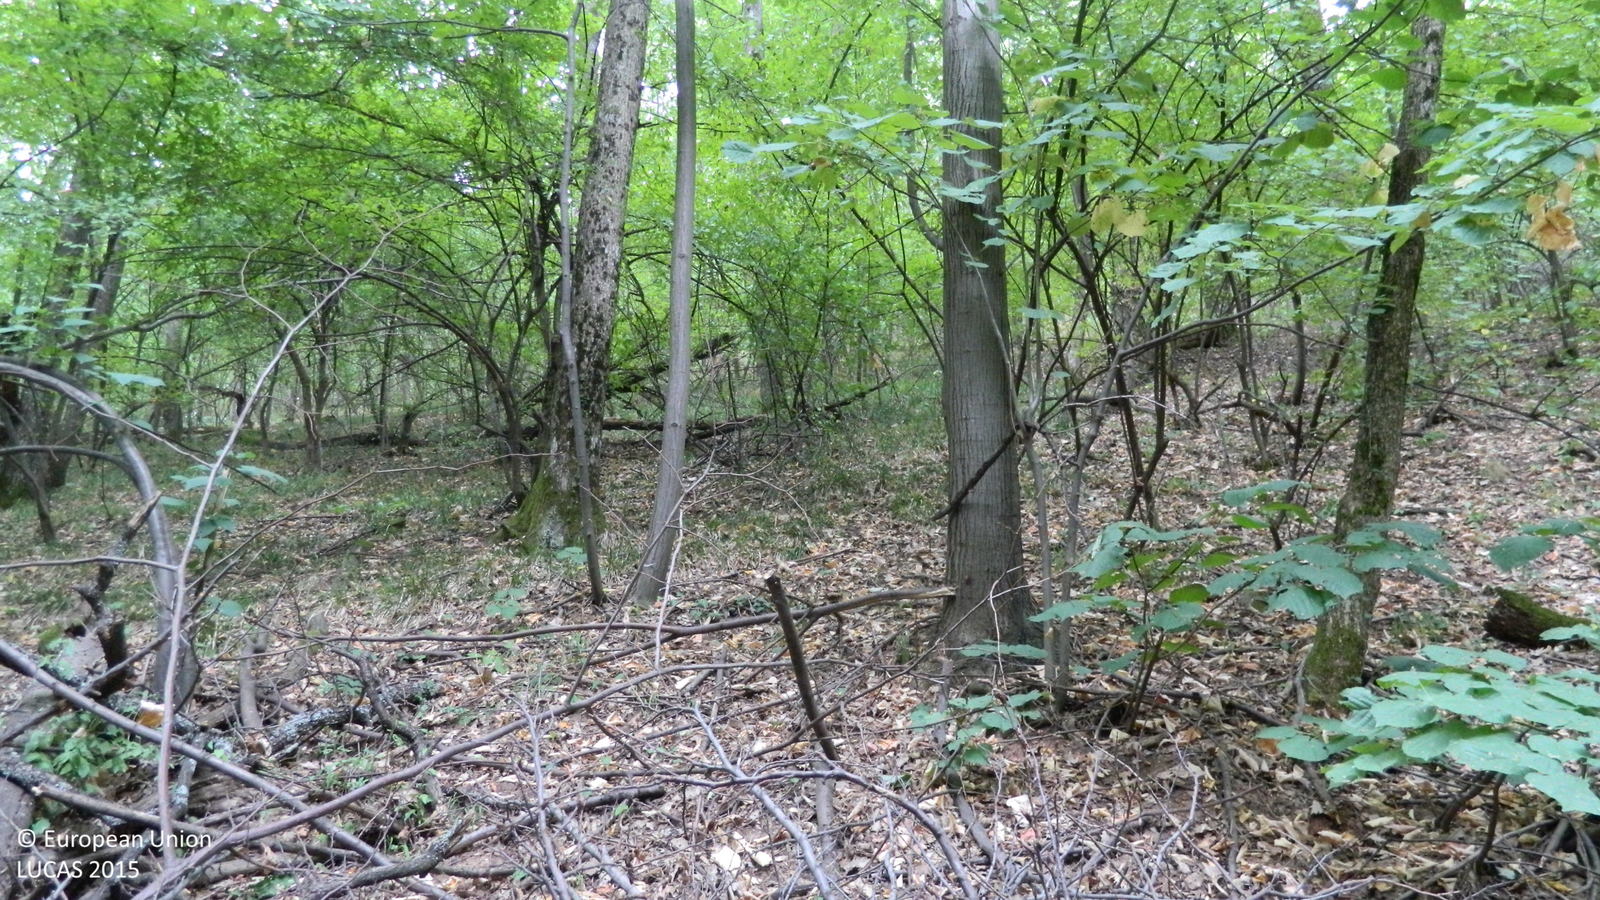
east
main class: Woodland
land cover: Broadleaved woodland
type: mesophytic deciduous forest
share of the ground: > 75 %
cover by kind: broadleaved forest trees 100 %
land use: Forestry
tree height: > 5 m
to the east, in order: Broadleaved woodland
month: August
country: BG
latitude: 41.7309
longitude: 25.8284
